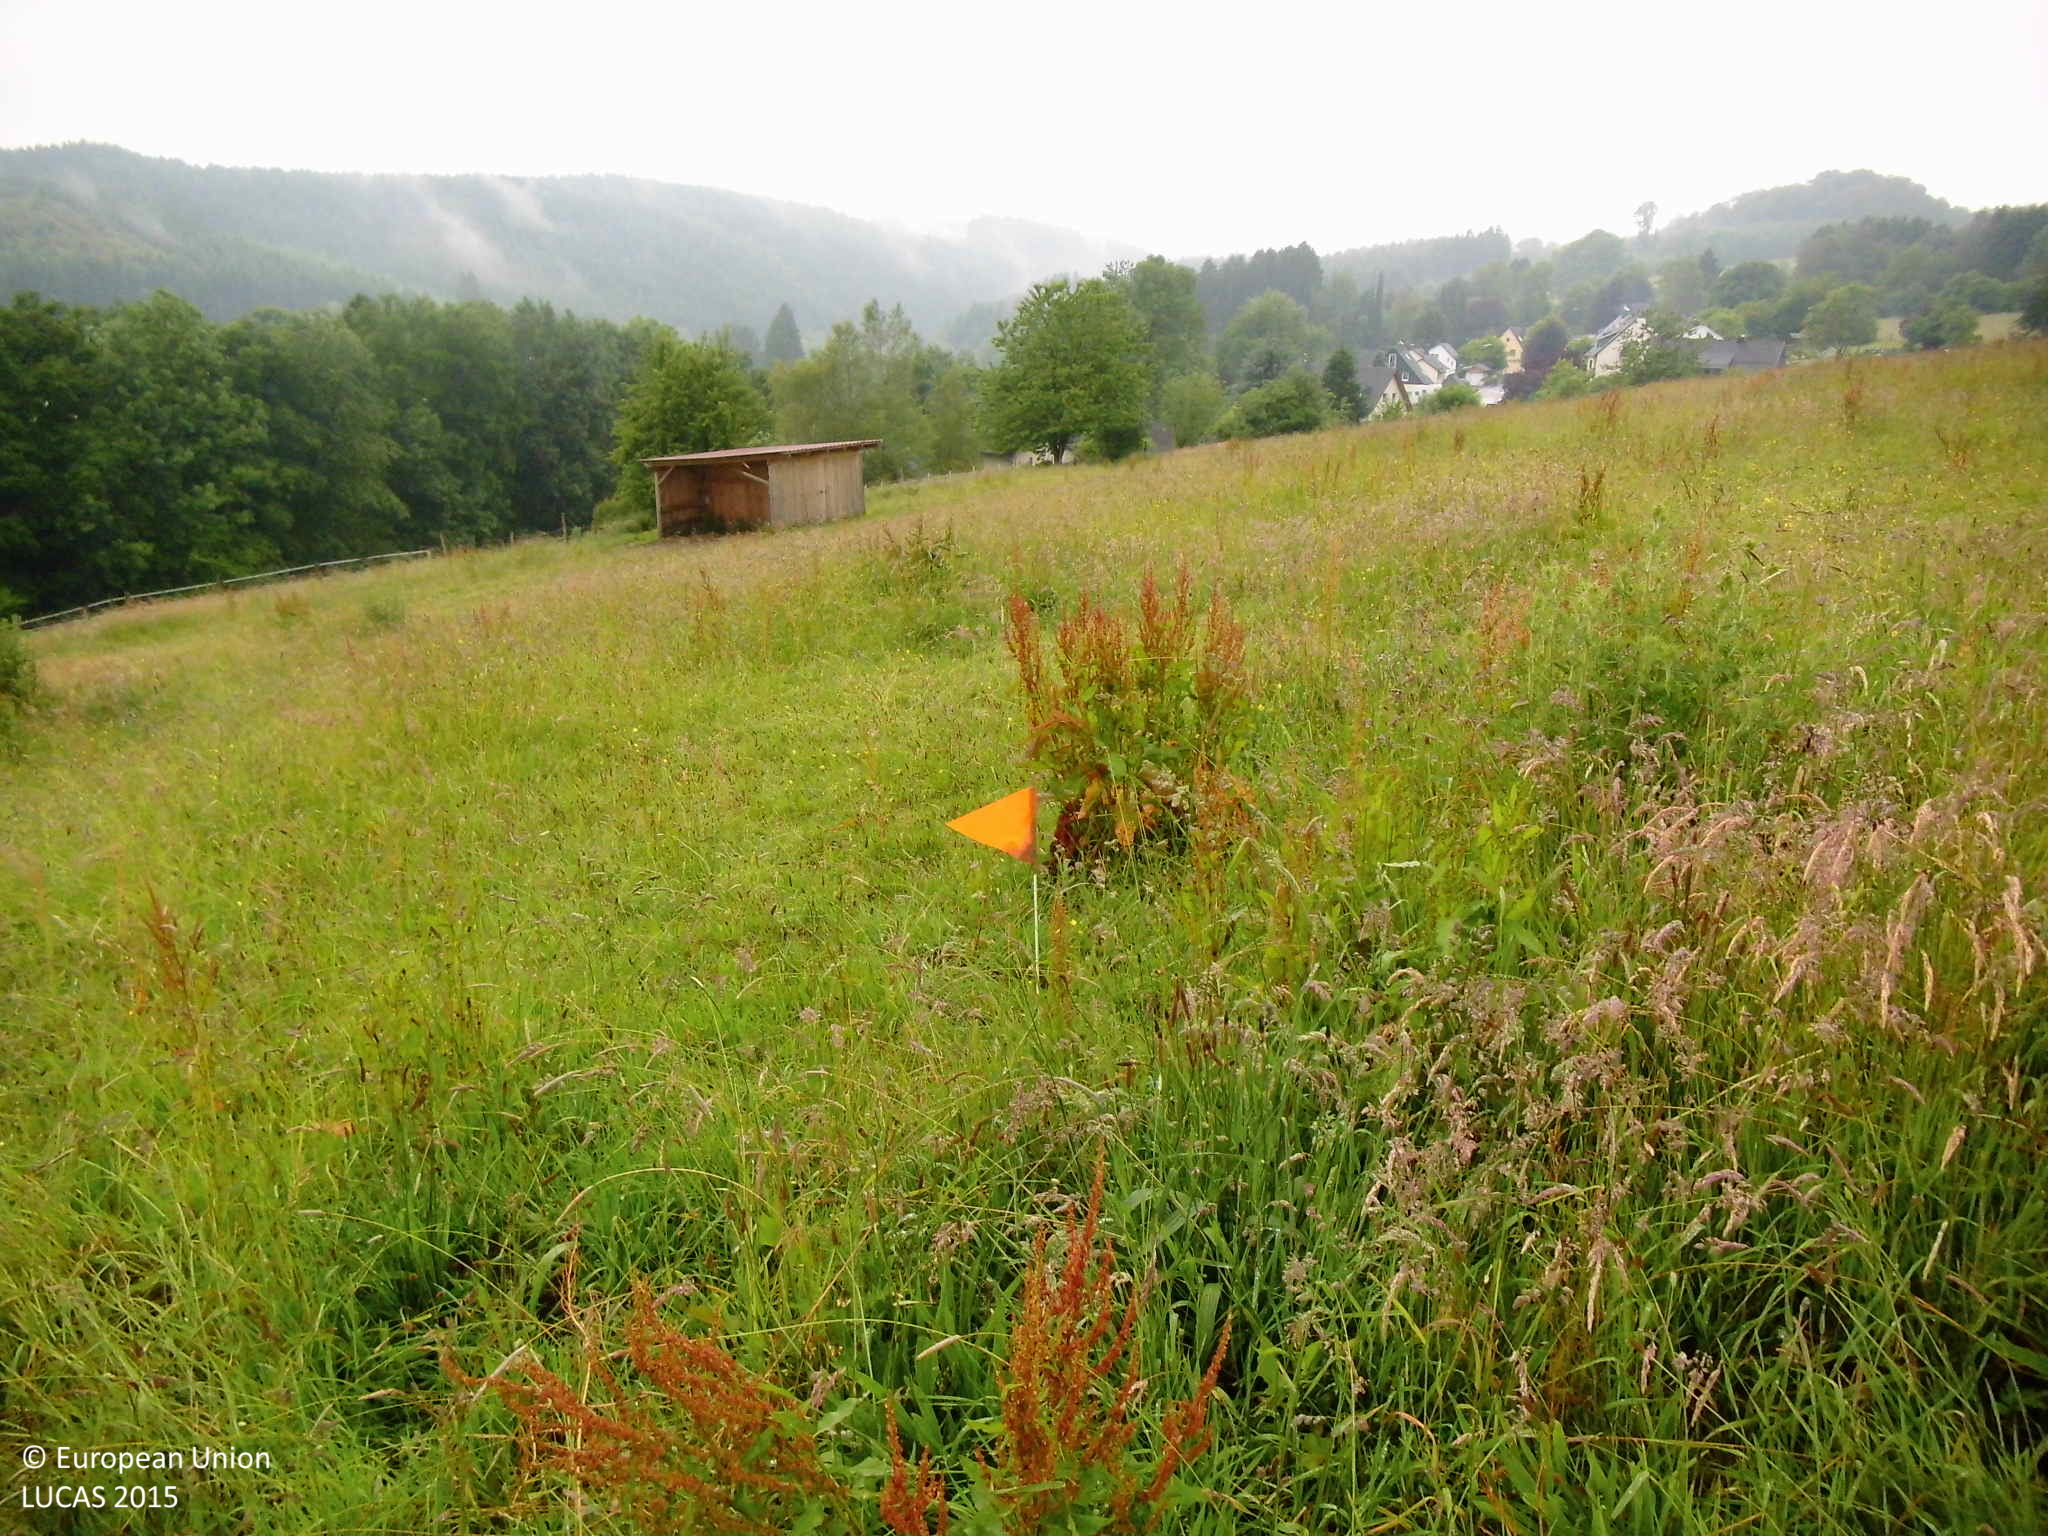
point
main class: Grassland
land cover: Grassland without tree/shrub cover
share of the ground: > 75 %
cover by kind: herbaceous plants 95 %, shrubs 5 %
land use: Agriculture (excluding fallow land and kitchen gardens)
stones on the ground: 10 - 25 %
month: June
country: DE
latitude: 51.0564
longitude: 7.5035
